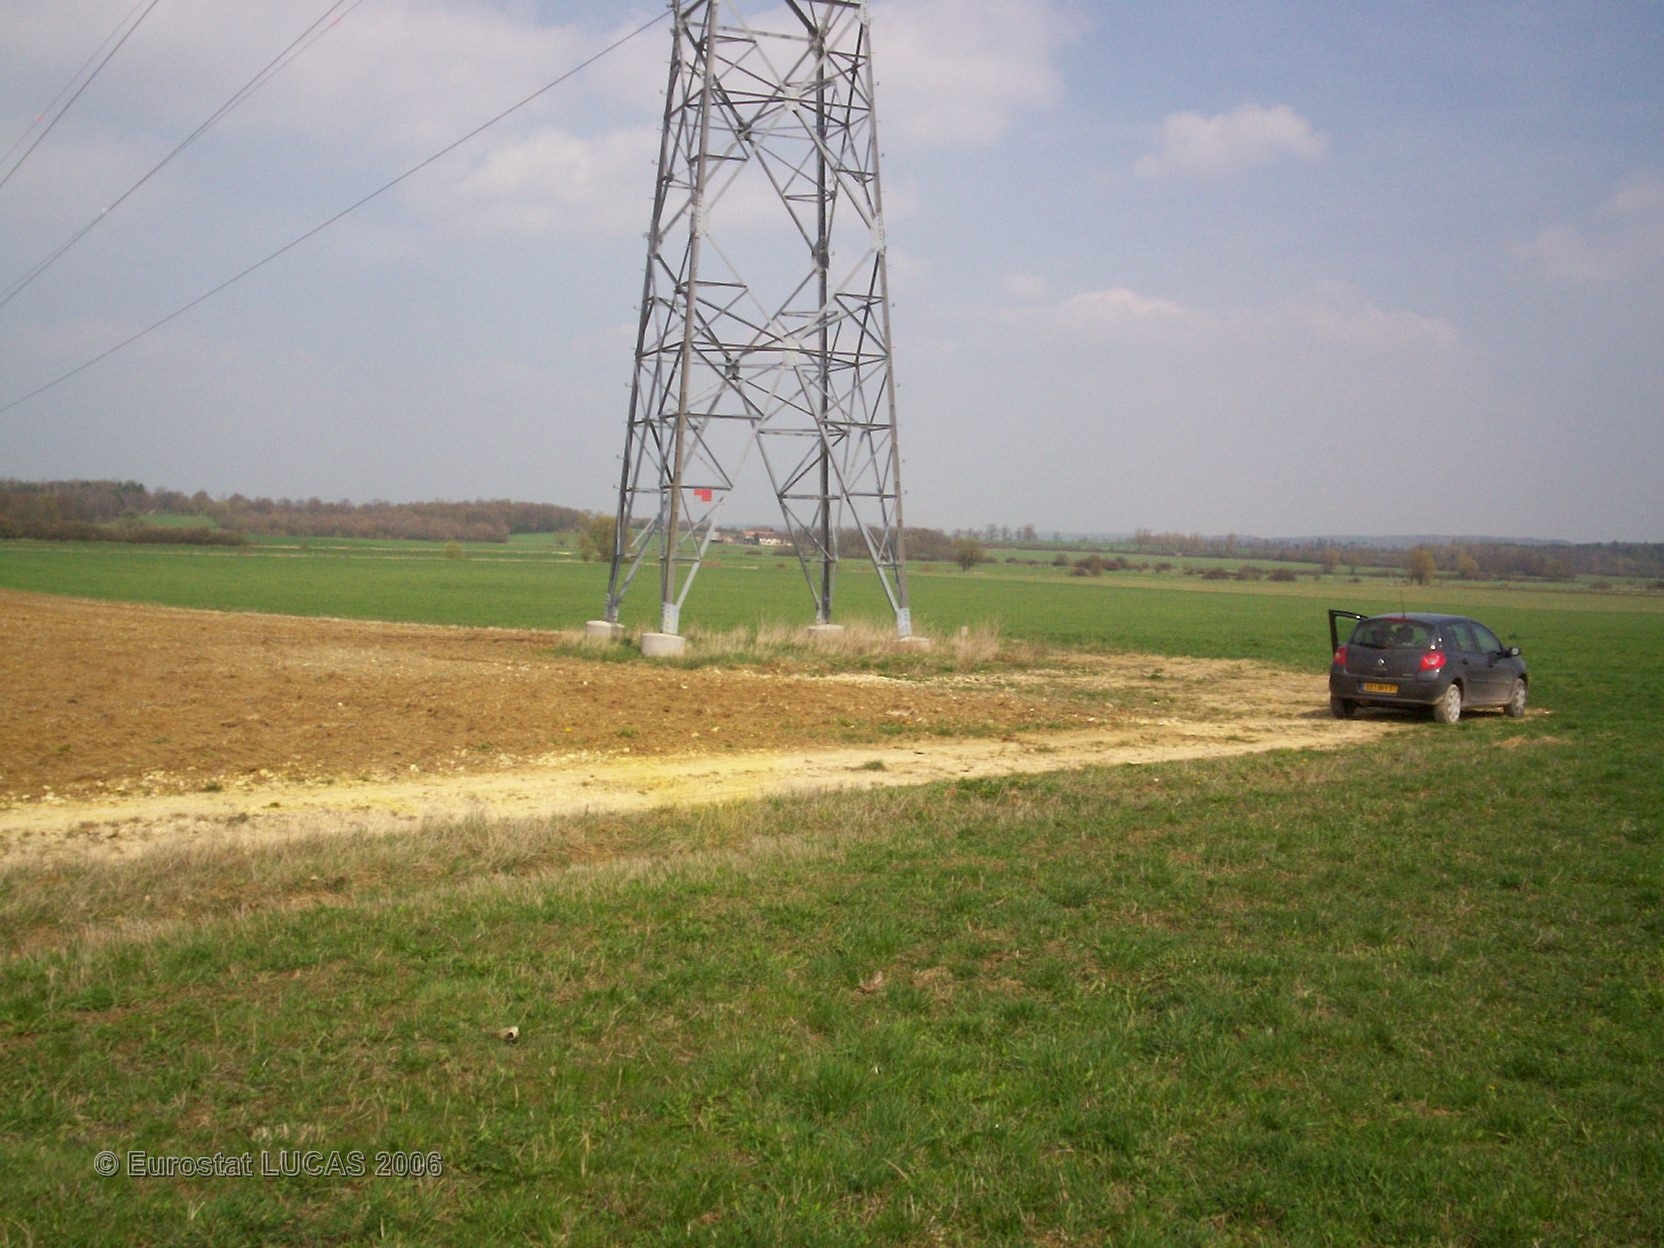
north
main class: Grassland
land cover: Grassland without tree/shrub cover
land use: Agriculture (excluding fallow land and kitchen gardens)
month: April
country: FR
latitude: 48.7421
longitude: 5.9065
